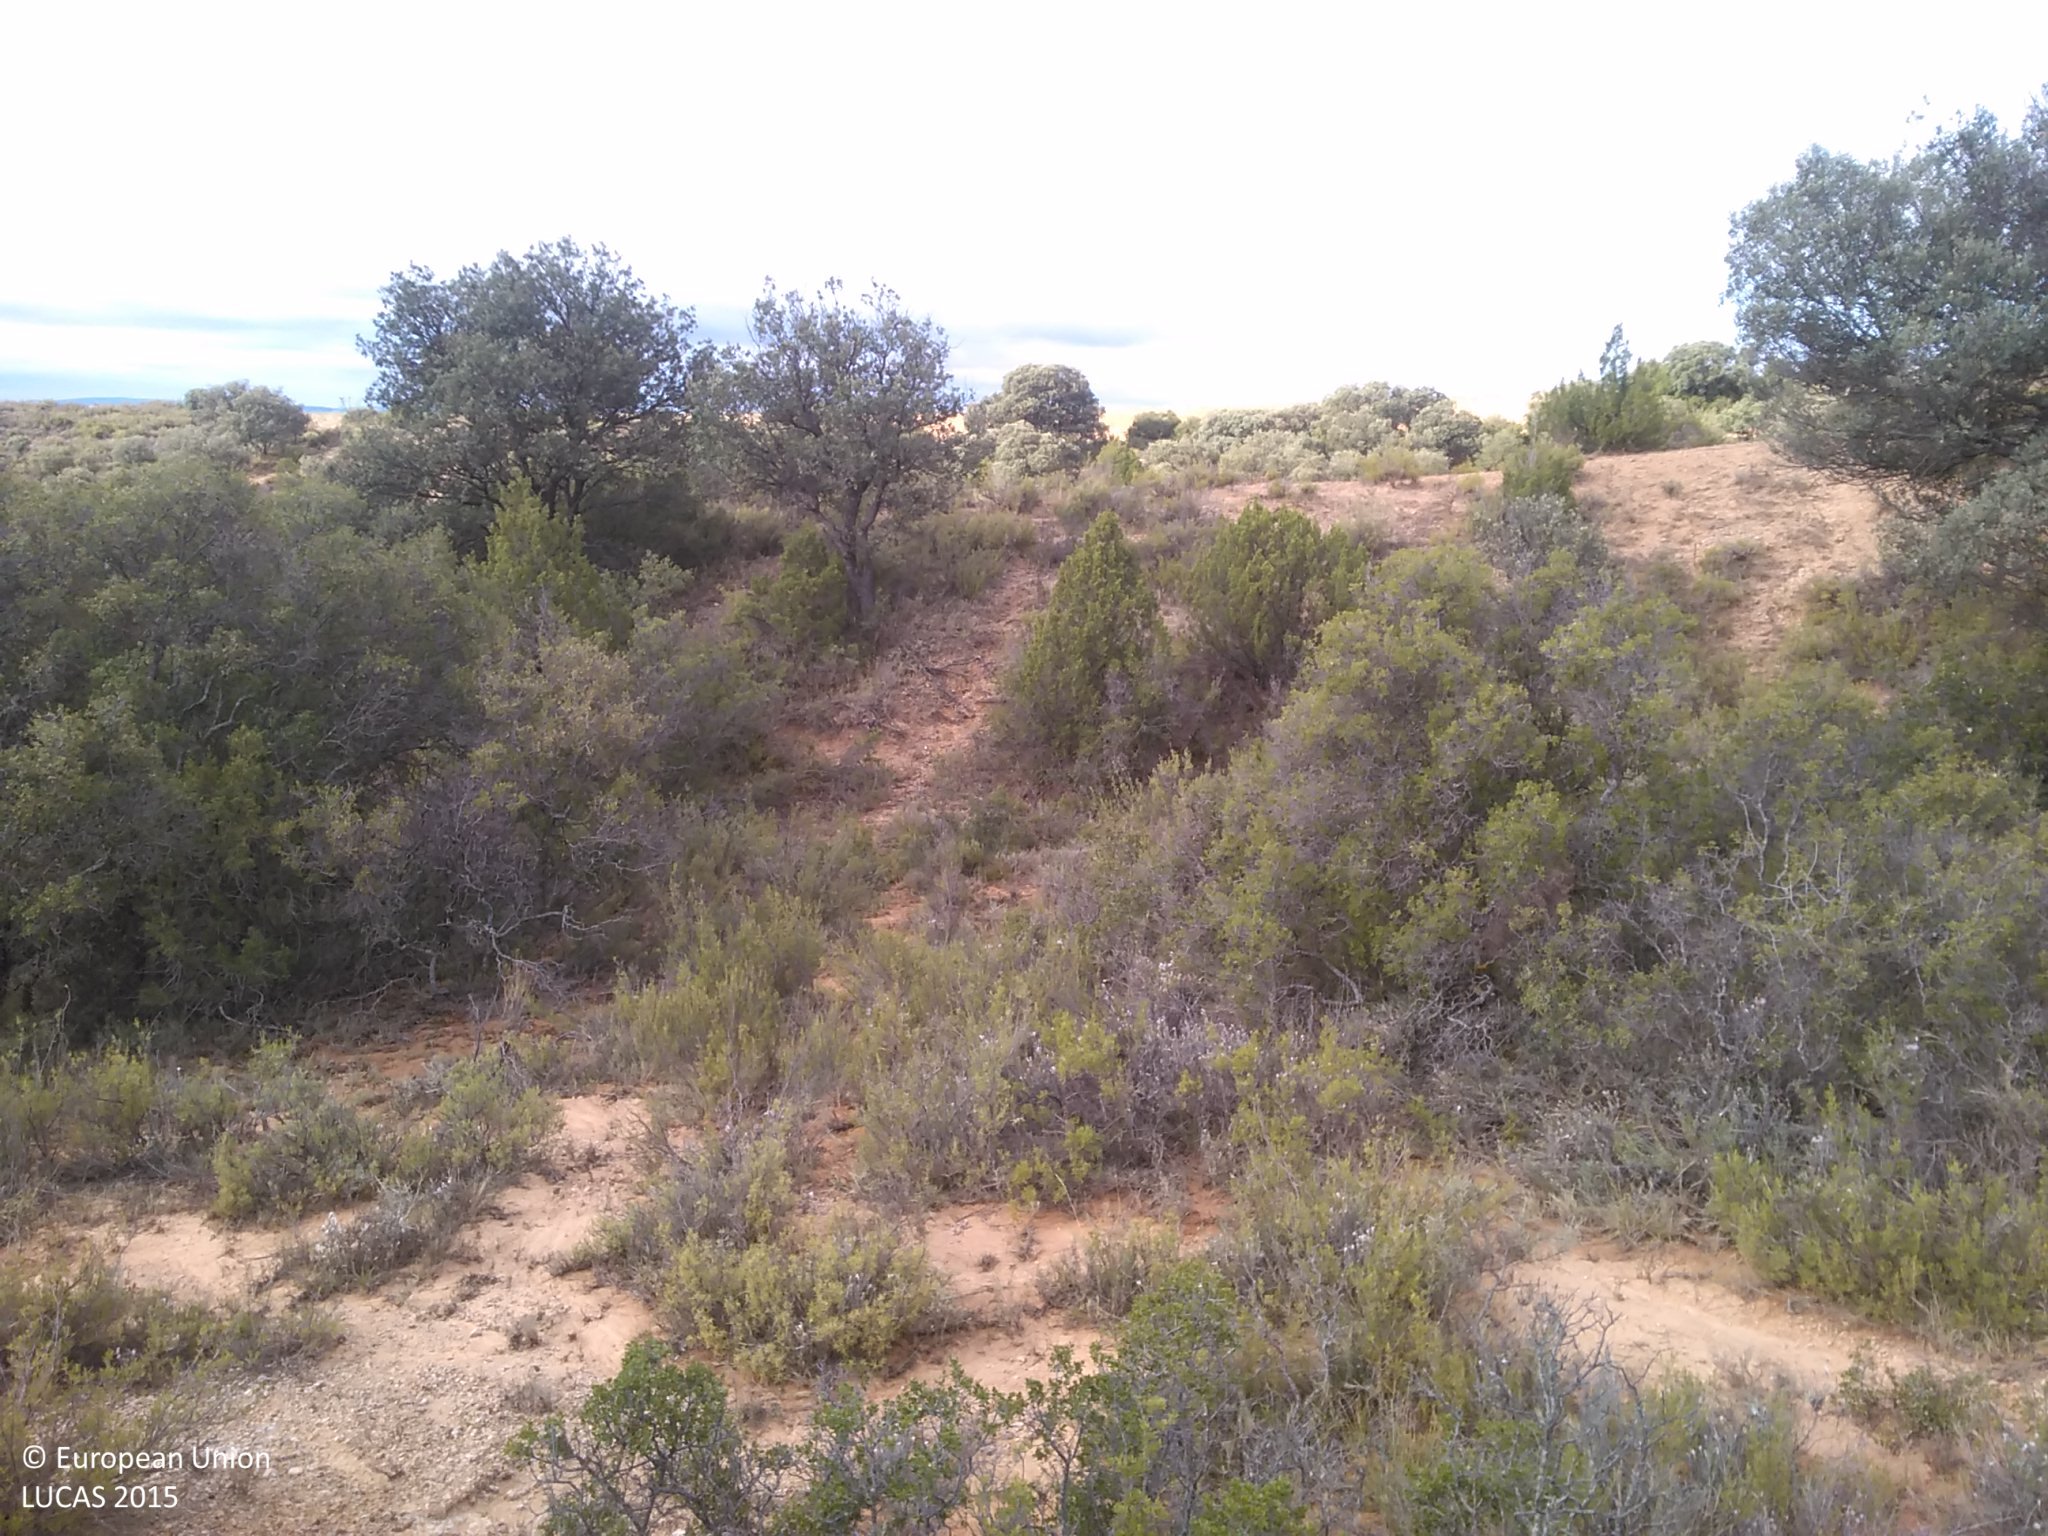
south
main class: Woodland
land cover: Other mixed woodland
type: coniferous forest of the mediterranean region
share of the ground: 25 - 50 %
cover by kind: shrubs 30 %, unconsolidated bare surface 25 %, coniferous forest trees 20 %, broadleaved forest trees 20 %, herbaceous plants 5 %
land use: Semi-natural and natural areas not in use
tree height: < 5 m
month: July
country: ES
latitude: 41.3548
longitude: -1.9934
